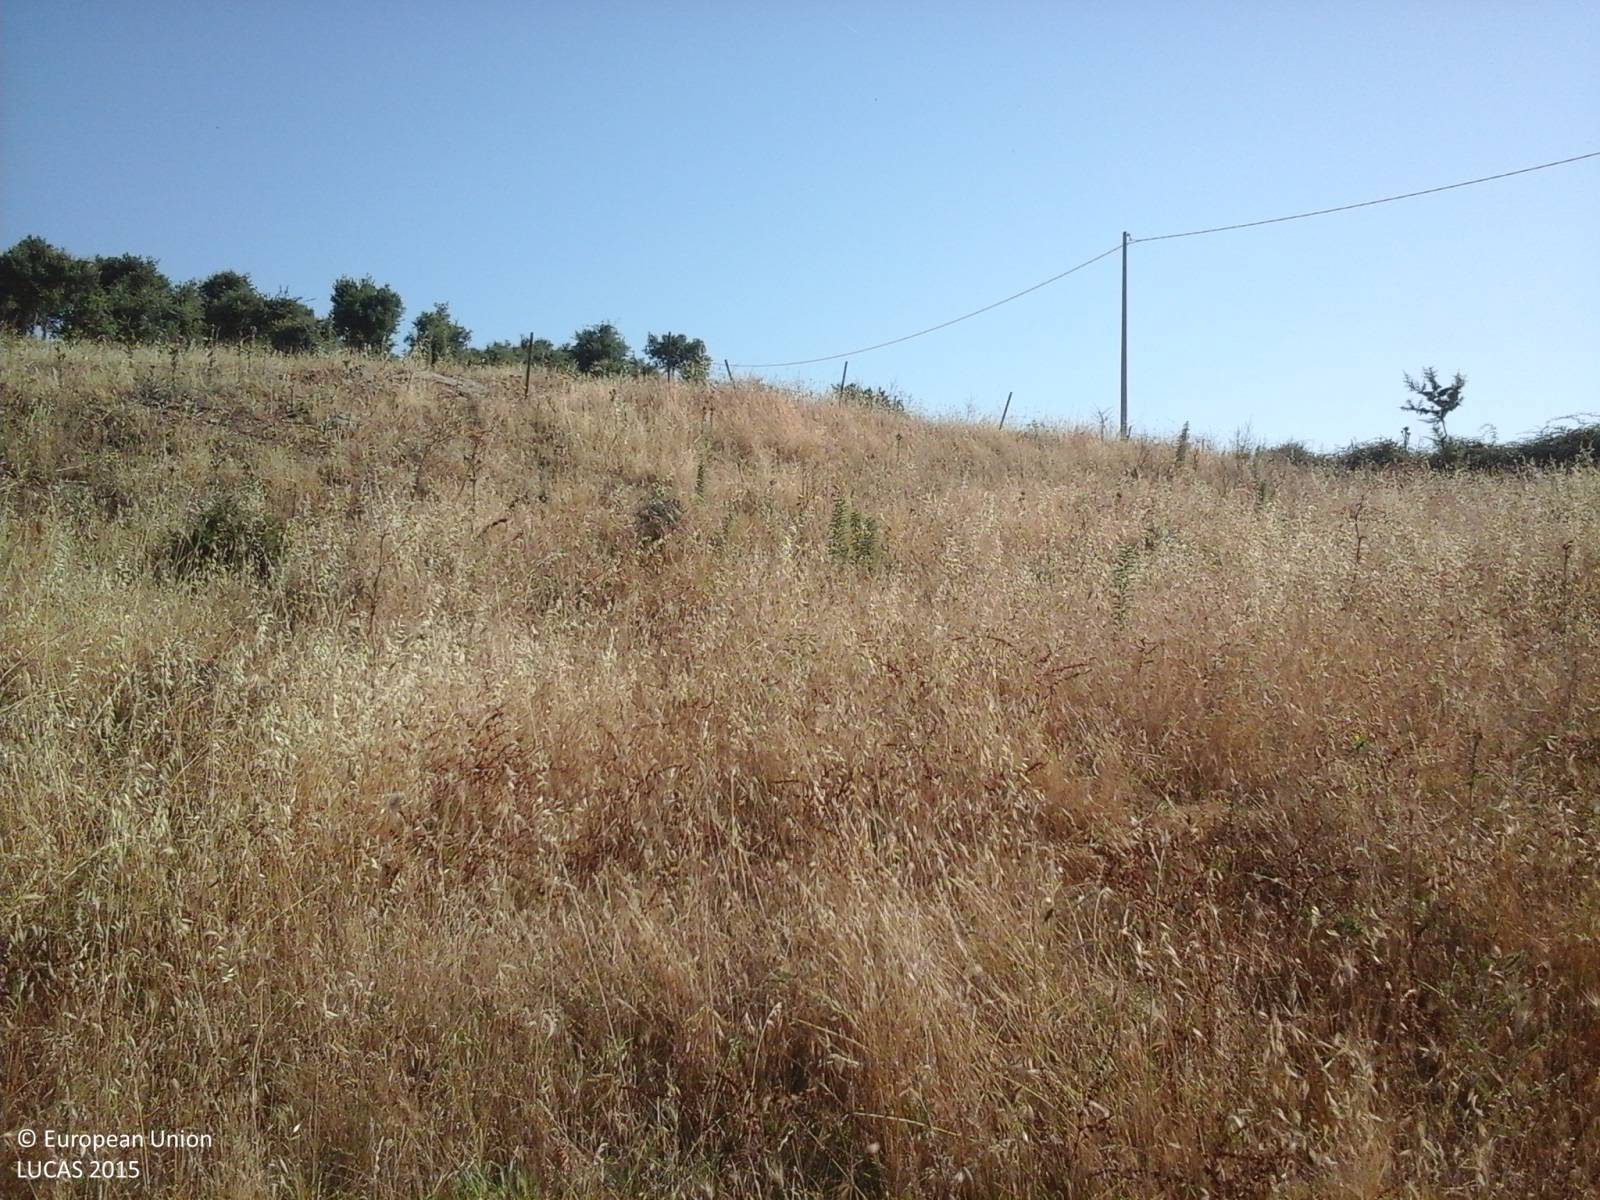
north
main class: Grassland
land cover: Grassland without tree/shrub cover
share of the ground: > 75 %
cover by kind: herbaceous plants 95 %, shrubs 5 %
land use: Agriculture (excluding fallow land and kitchen gardens)
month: July
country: IT
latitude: 40.4831
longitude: 9.4718
